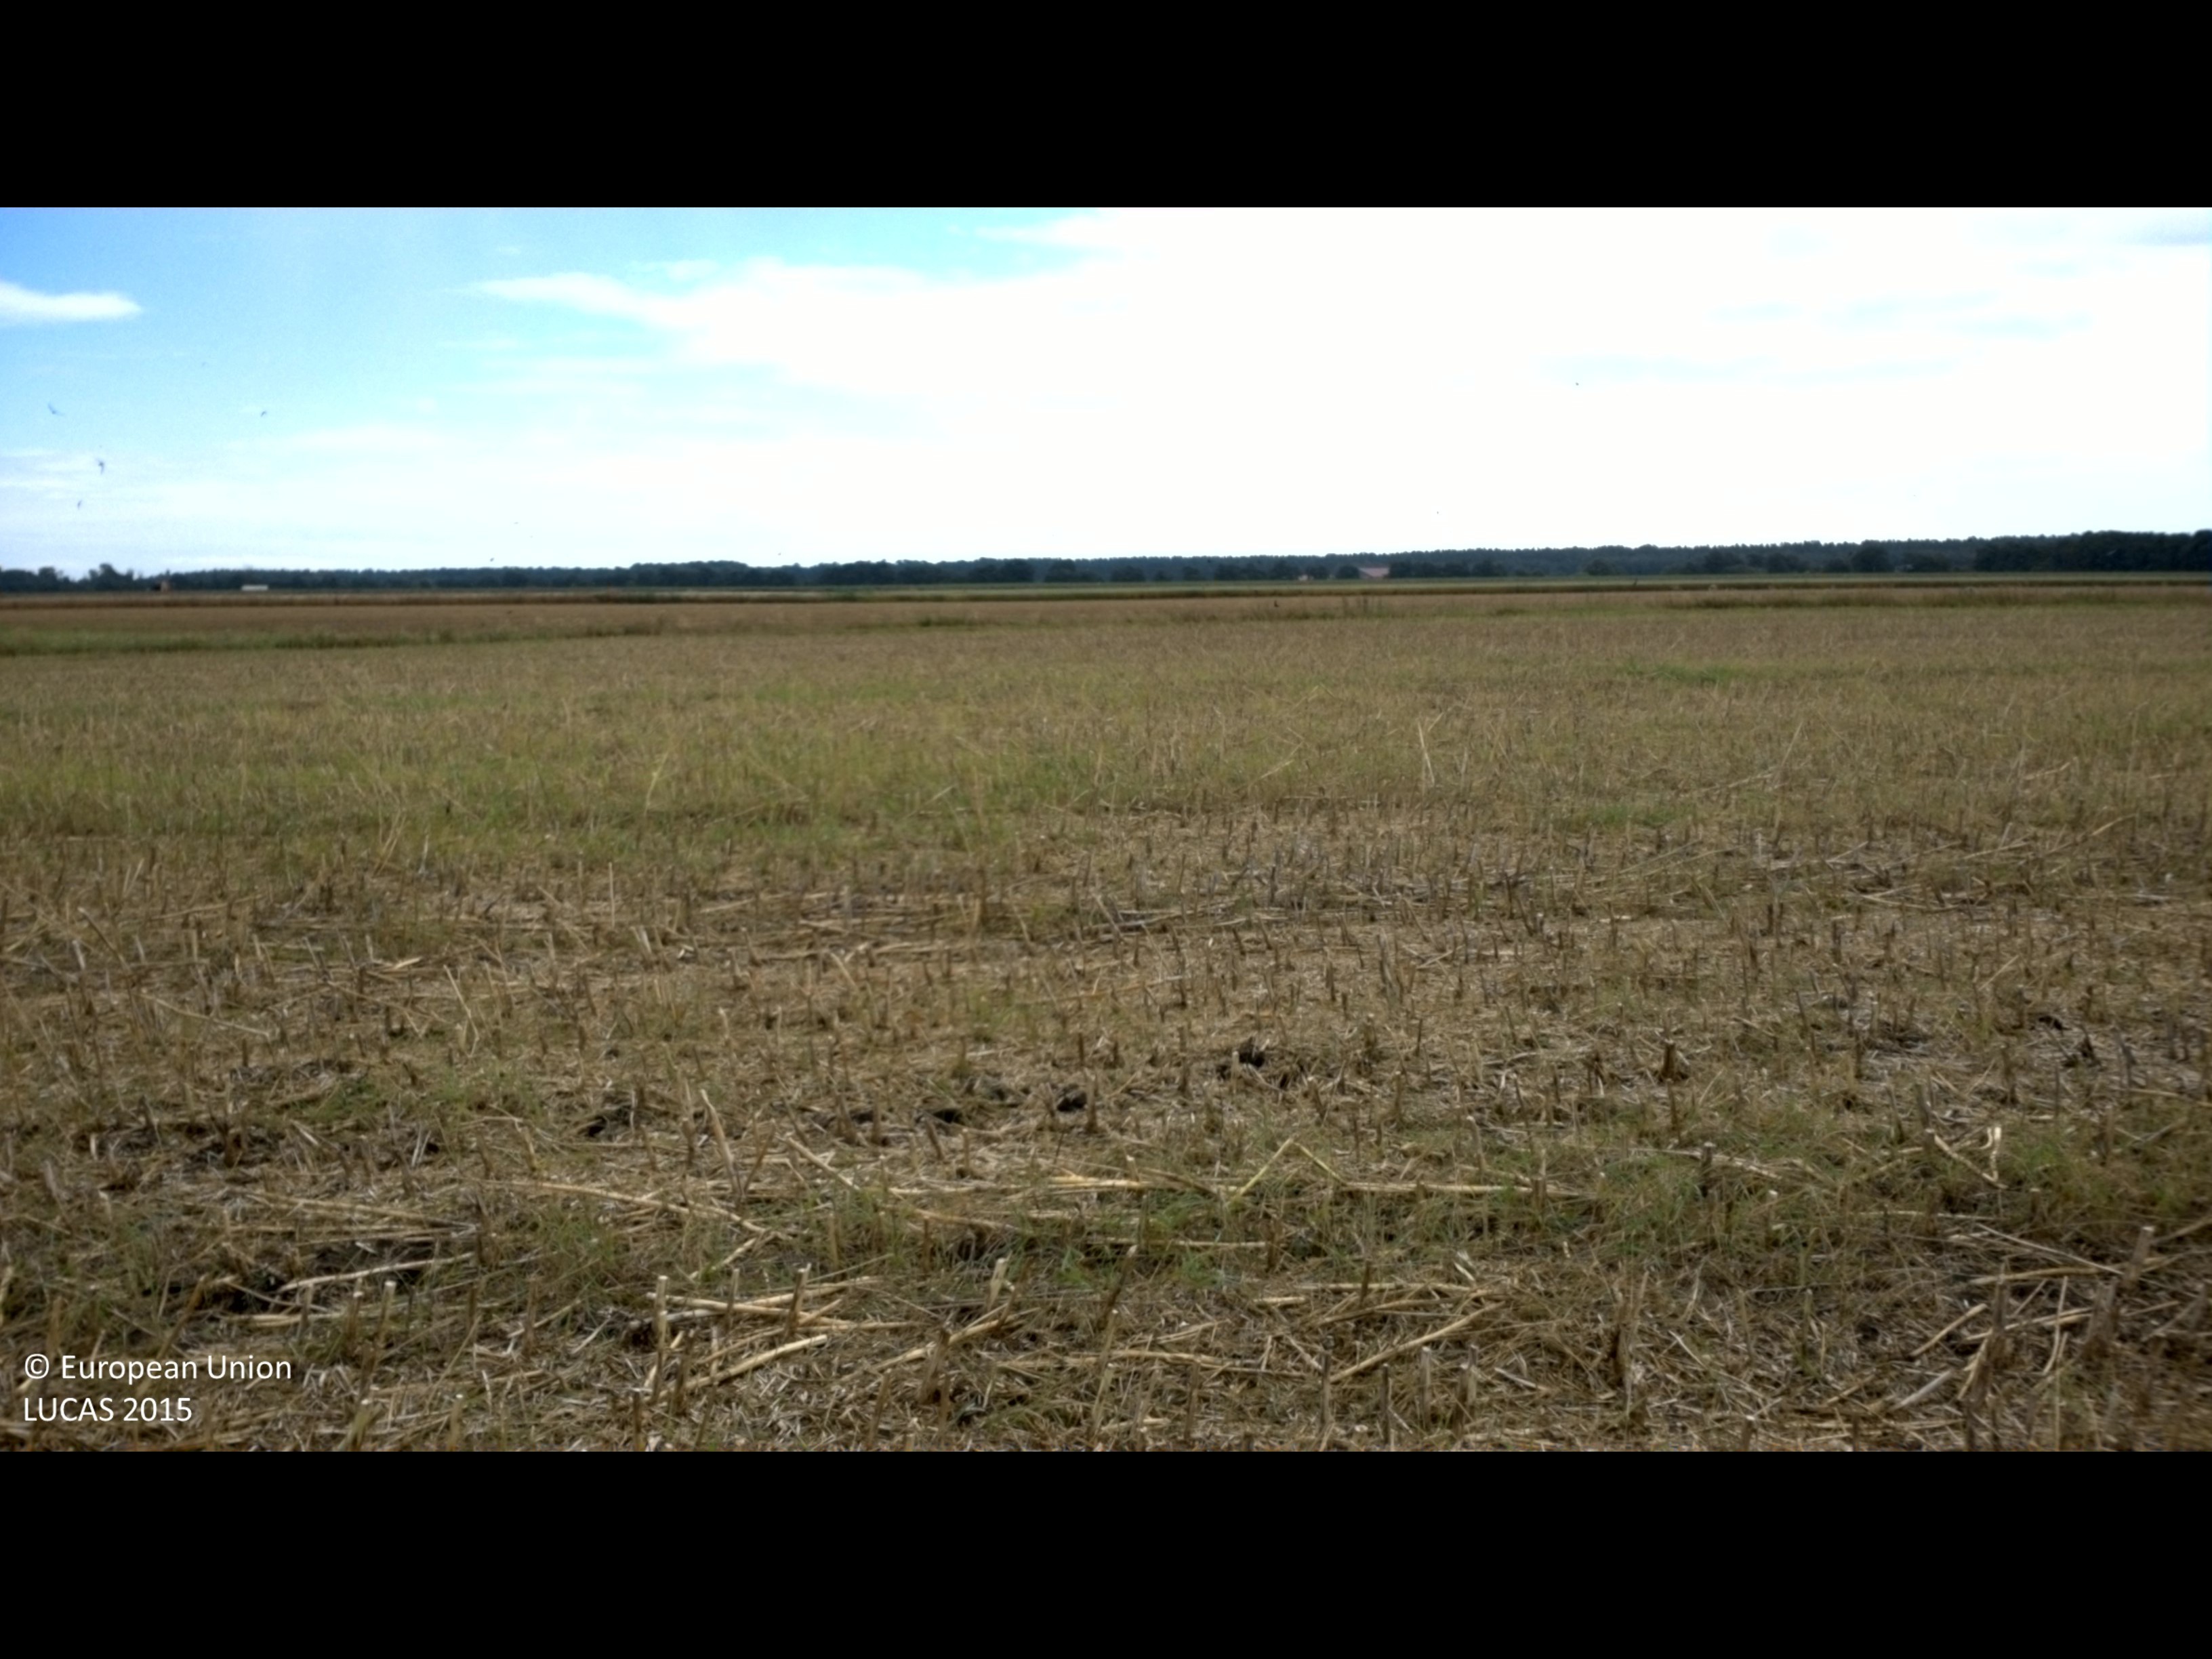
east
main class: Cropland
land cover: Rape and turnip rape
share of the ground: 10 - 25 %
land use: Agriculture (excluding fallow land and kitchen gardens)
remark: Harvested field
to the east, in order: Rape and turnip rape; Grass margins; Tracks; Grass margins; Dry pulses; Common wheat
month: July
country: SE
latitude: 55.9019
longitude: 14.2366
